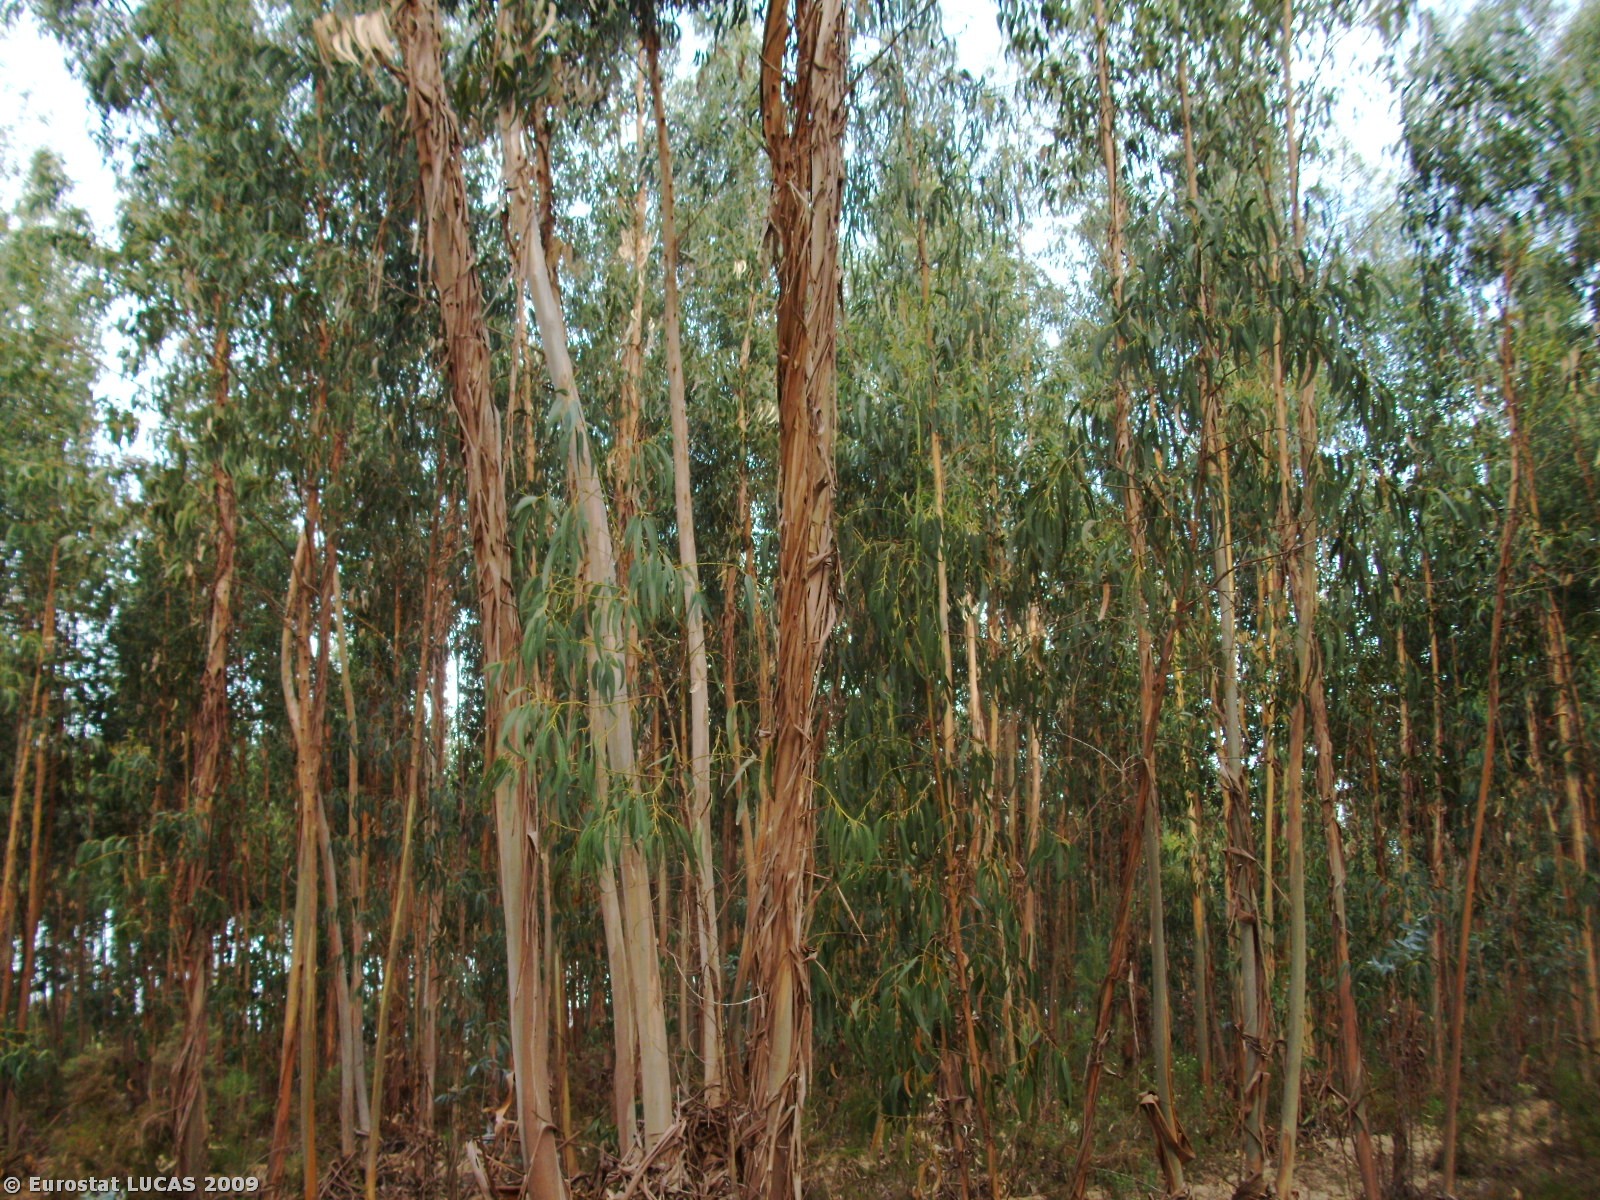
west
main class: Woodland
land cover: Mixed woodland
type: hemiboreal forest and nemoral coniferous forest and mixed broadleaved-coniferous forest
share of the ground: > 75 %
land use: Forestry
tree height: > 5 m
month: August
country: PT
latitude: 39.0776
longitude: -8.7155
